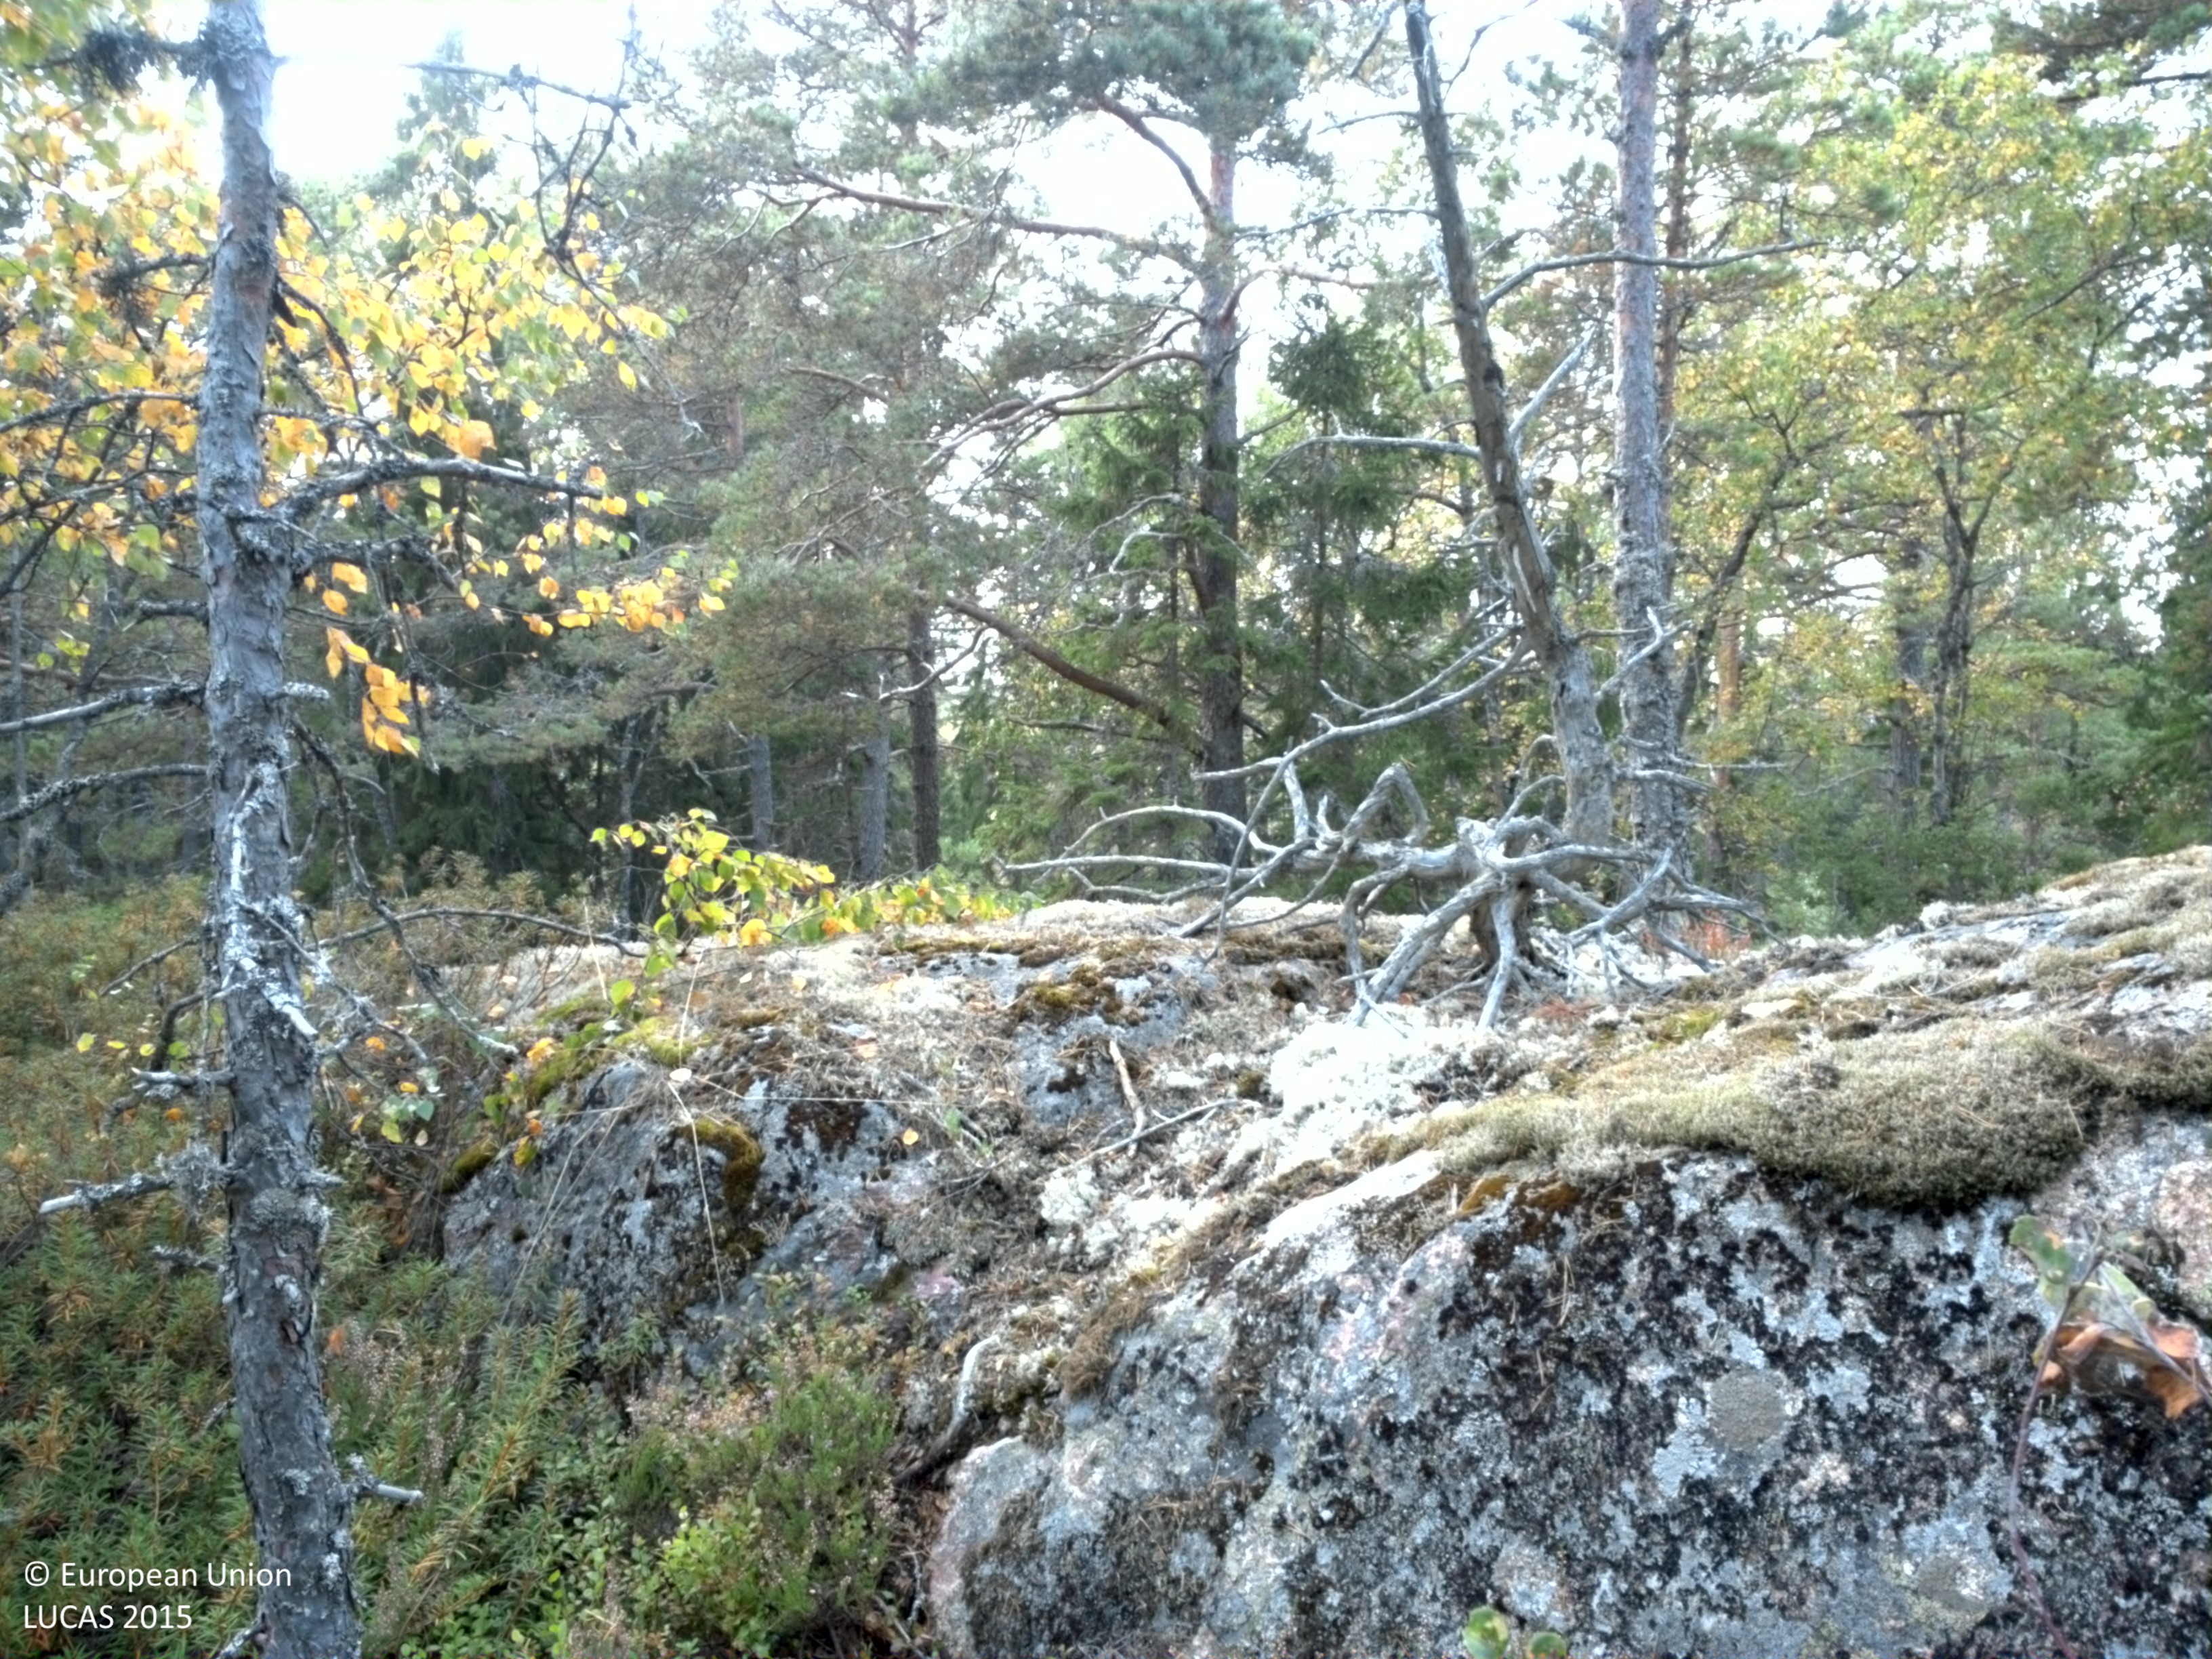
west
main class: Woodland
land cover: Pine dominated coniferous woodland
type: boreal forest
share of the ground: 50 - 75 %
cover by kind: coniferous forest trees 60 %, shrubs 20 %, consolidated bare surface 15 %, lichens and mosses 5 %
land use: Forestry
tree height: > 5 m
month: September
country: SE
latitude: 59.8131
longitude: 18.8262
